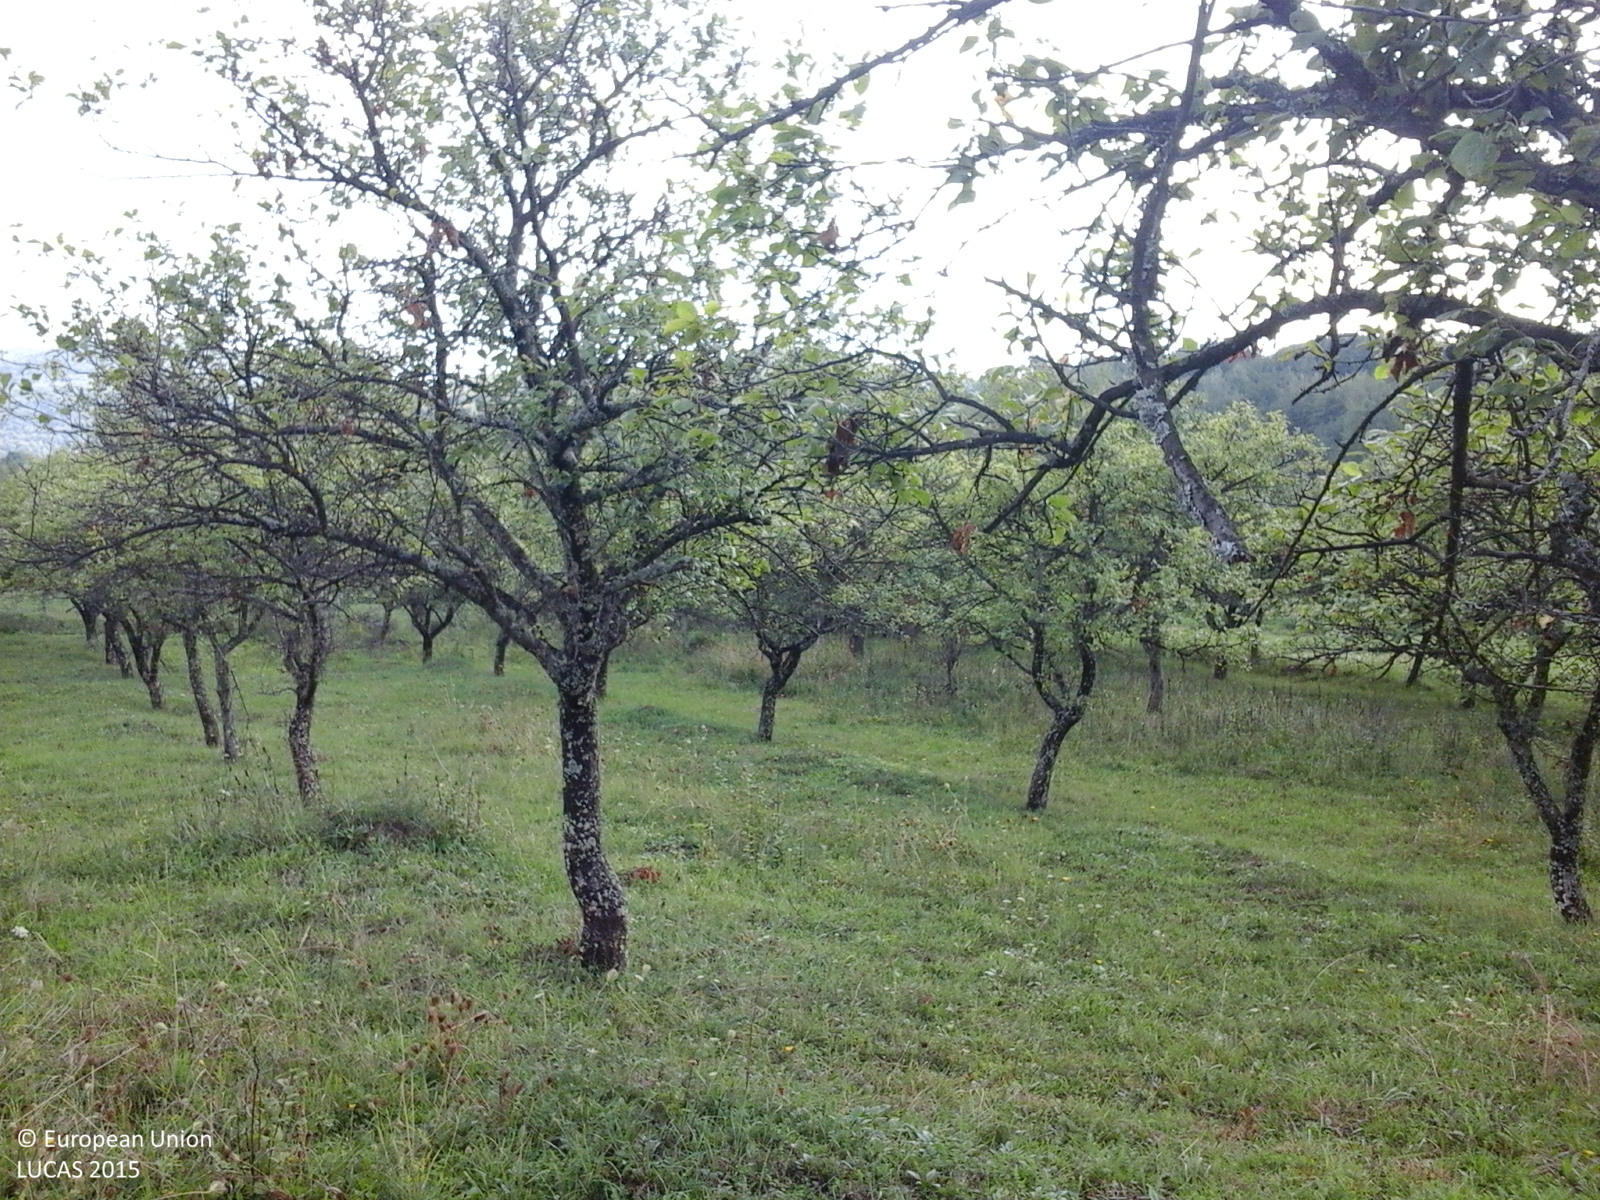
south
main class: Cropland
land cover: Other fruit trees and berries
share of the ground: 50 - 75 %
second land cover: Grassland without tree/shrub cover
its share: > 75 %
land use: Agriculture (excluding fallow land and kitchen gardens)
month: September
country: RO
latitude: 45.2100
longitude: 24.5031
